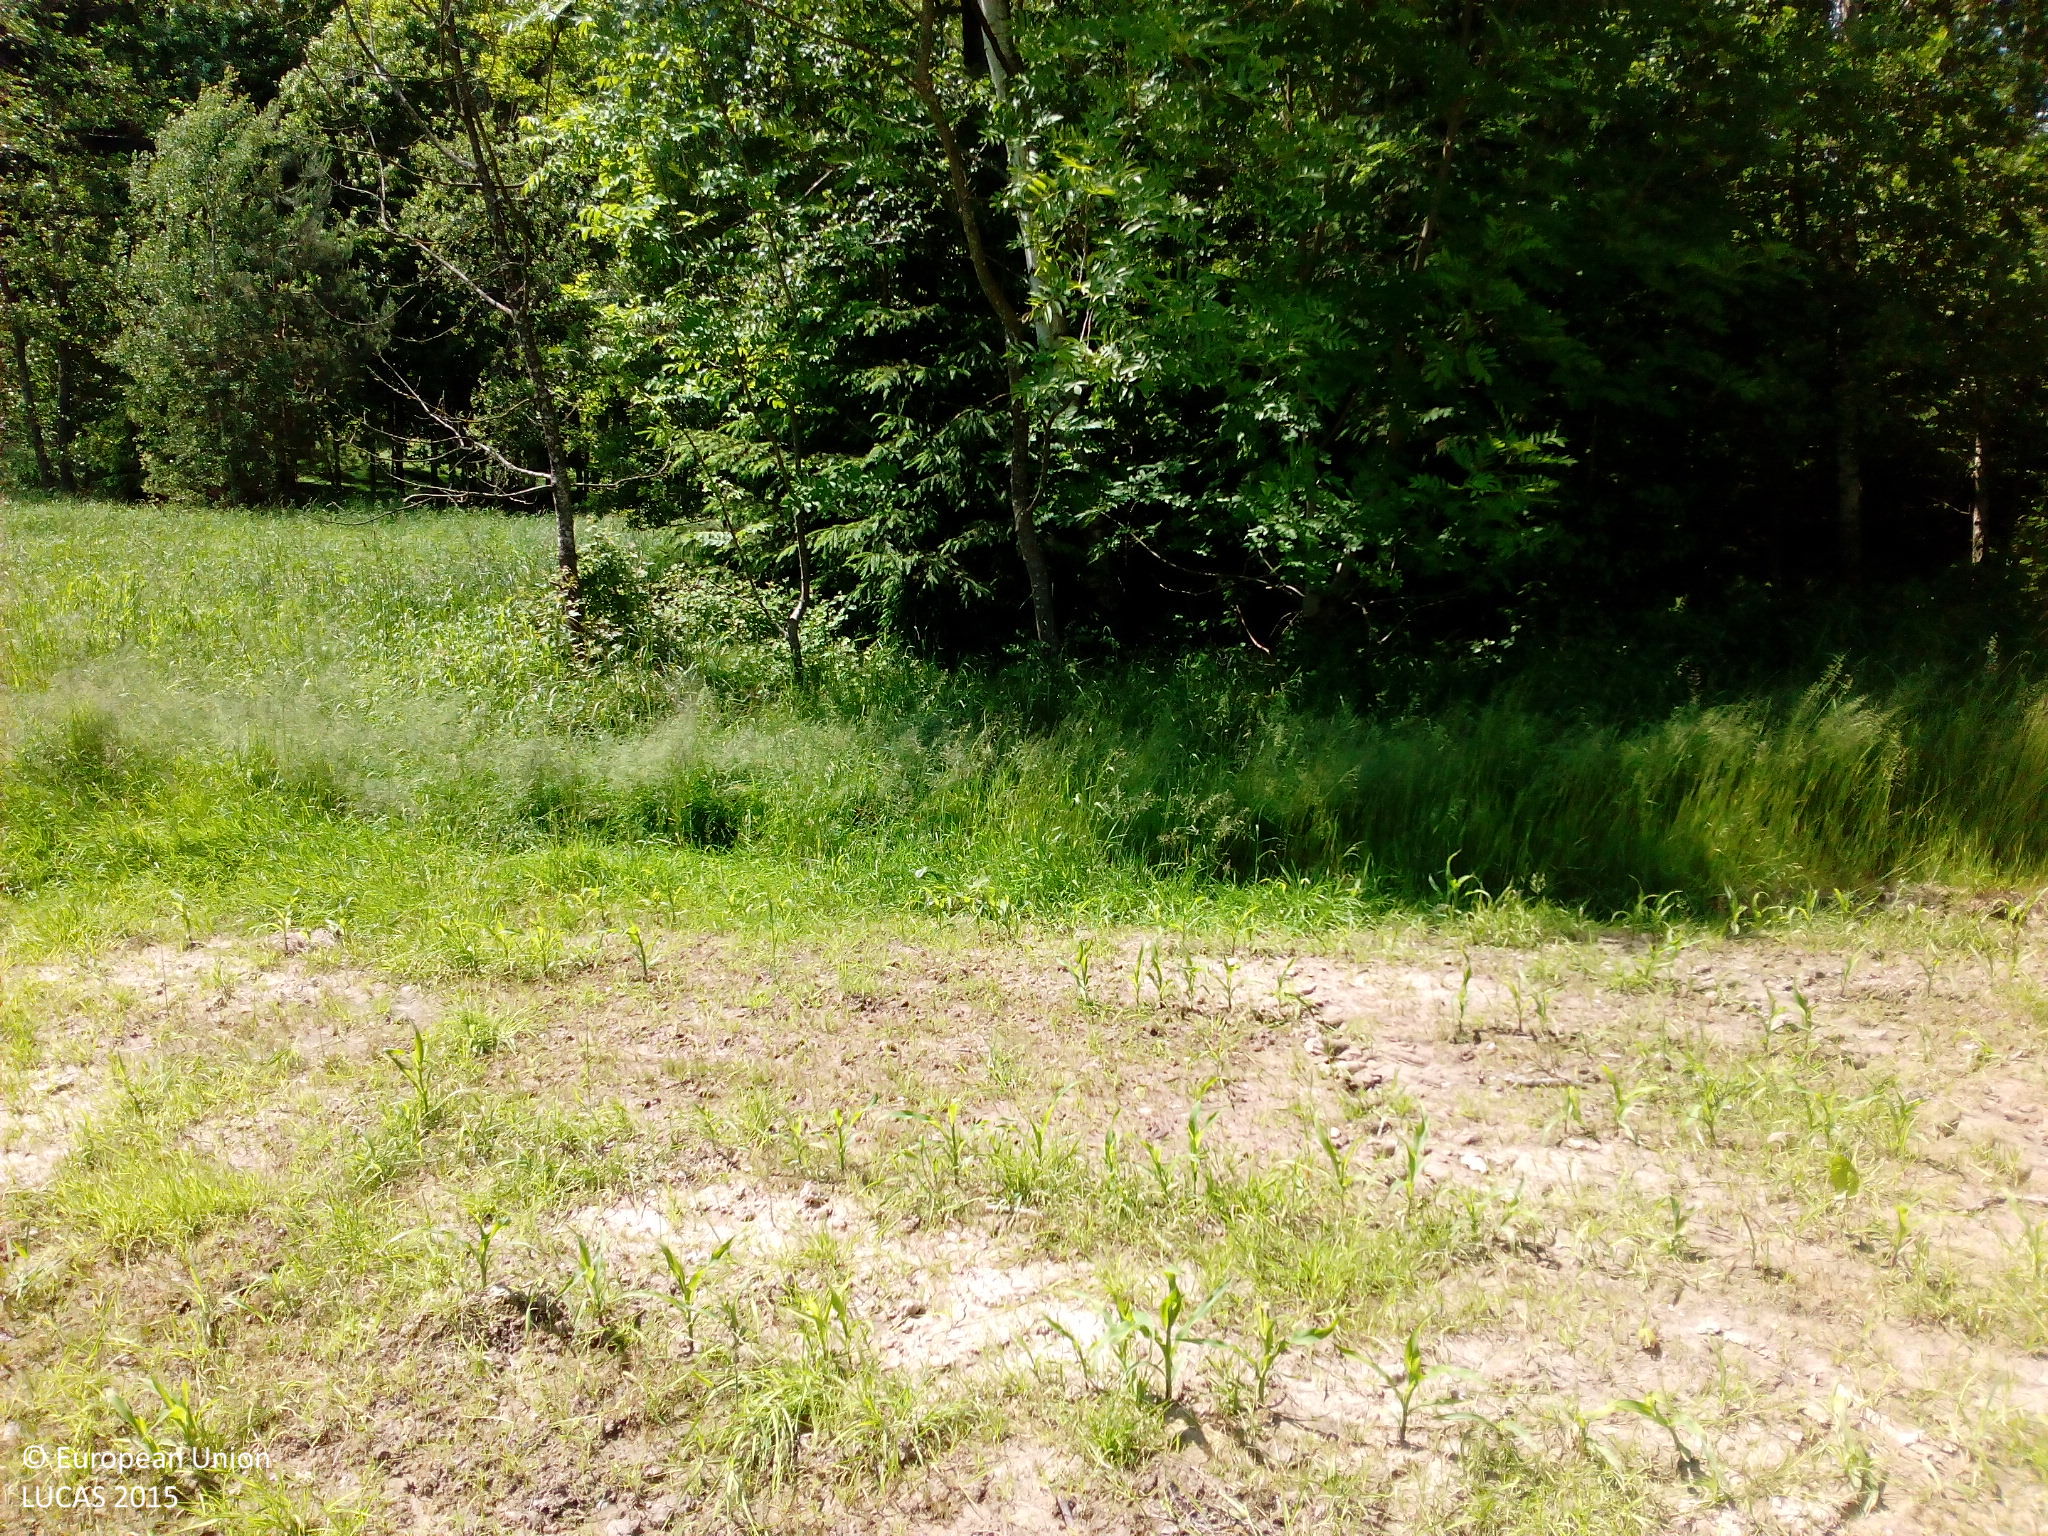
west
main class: Cropland
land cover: Maize
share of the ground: < 10 %
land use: Agriculture (excluding fallow land and kitchen gardens)
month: June
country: DE
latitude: 48.5216
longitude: 12.3956
